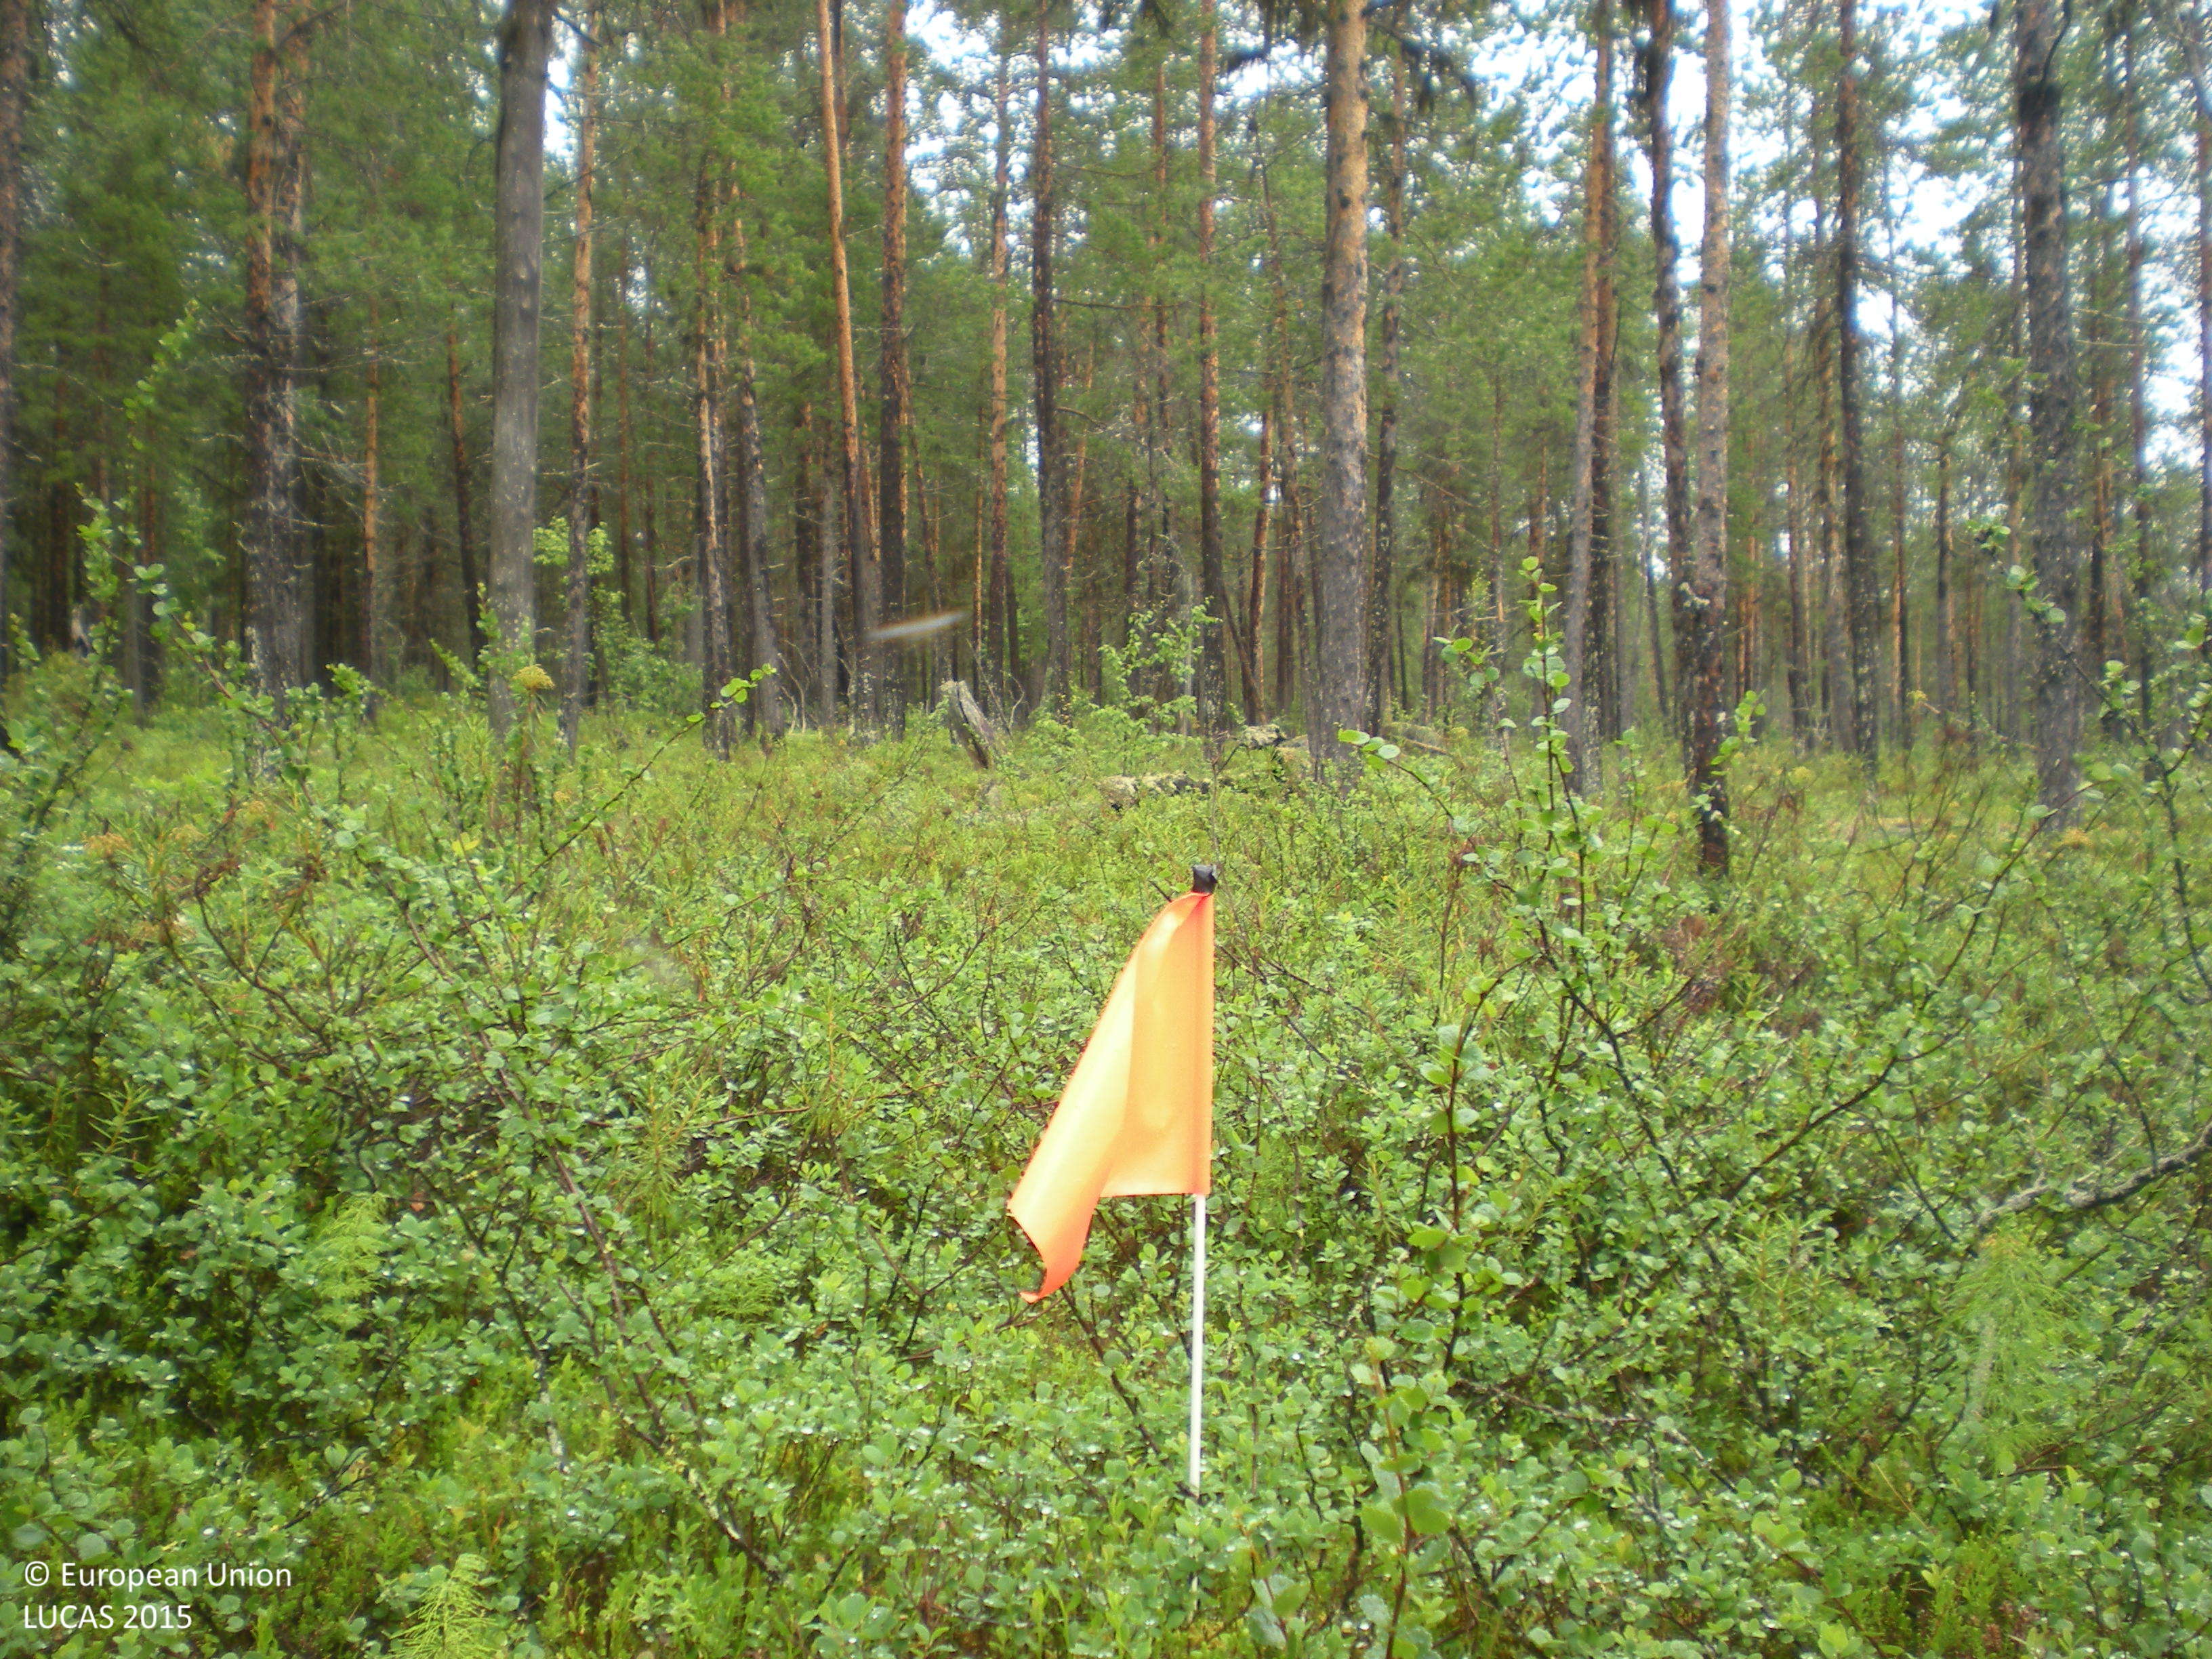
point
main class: Woodland
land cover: Pine dominated coniferous woodland
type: mire and swamp forests
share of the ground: 50 - 75 %
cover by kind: coniferous forest trees 60 %, shrubs 20 %, broadleaved forest trees 10 %, lichens and mosses 5 %, consolidated bare surface 5 %
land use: Forestry
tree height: > 5 m
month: August
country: SE
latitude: 66.1217
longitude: 18.0352
